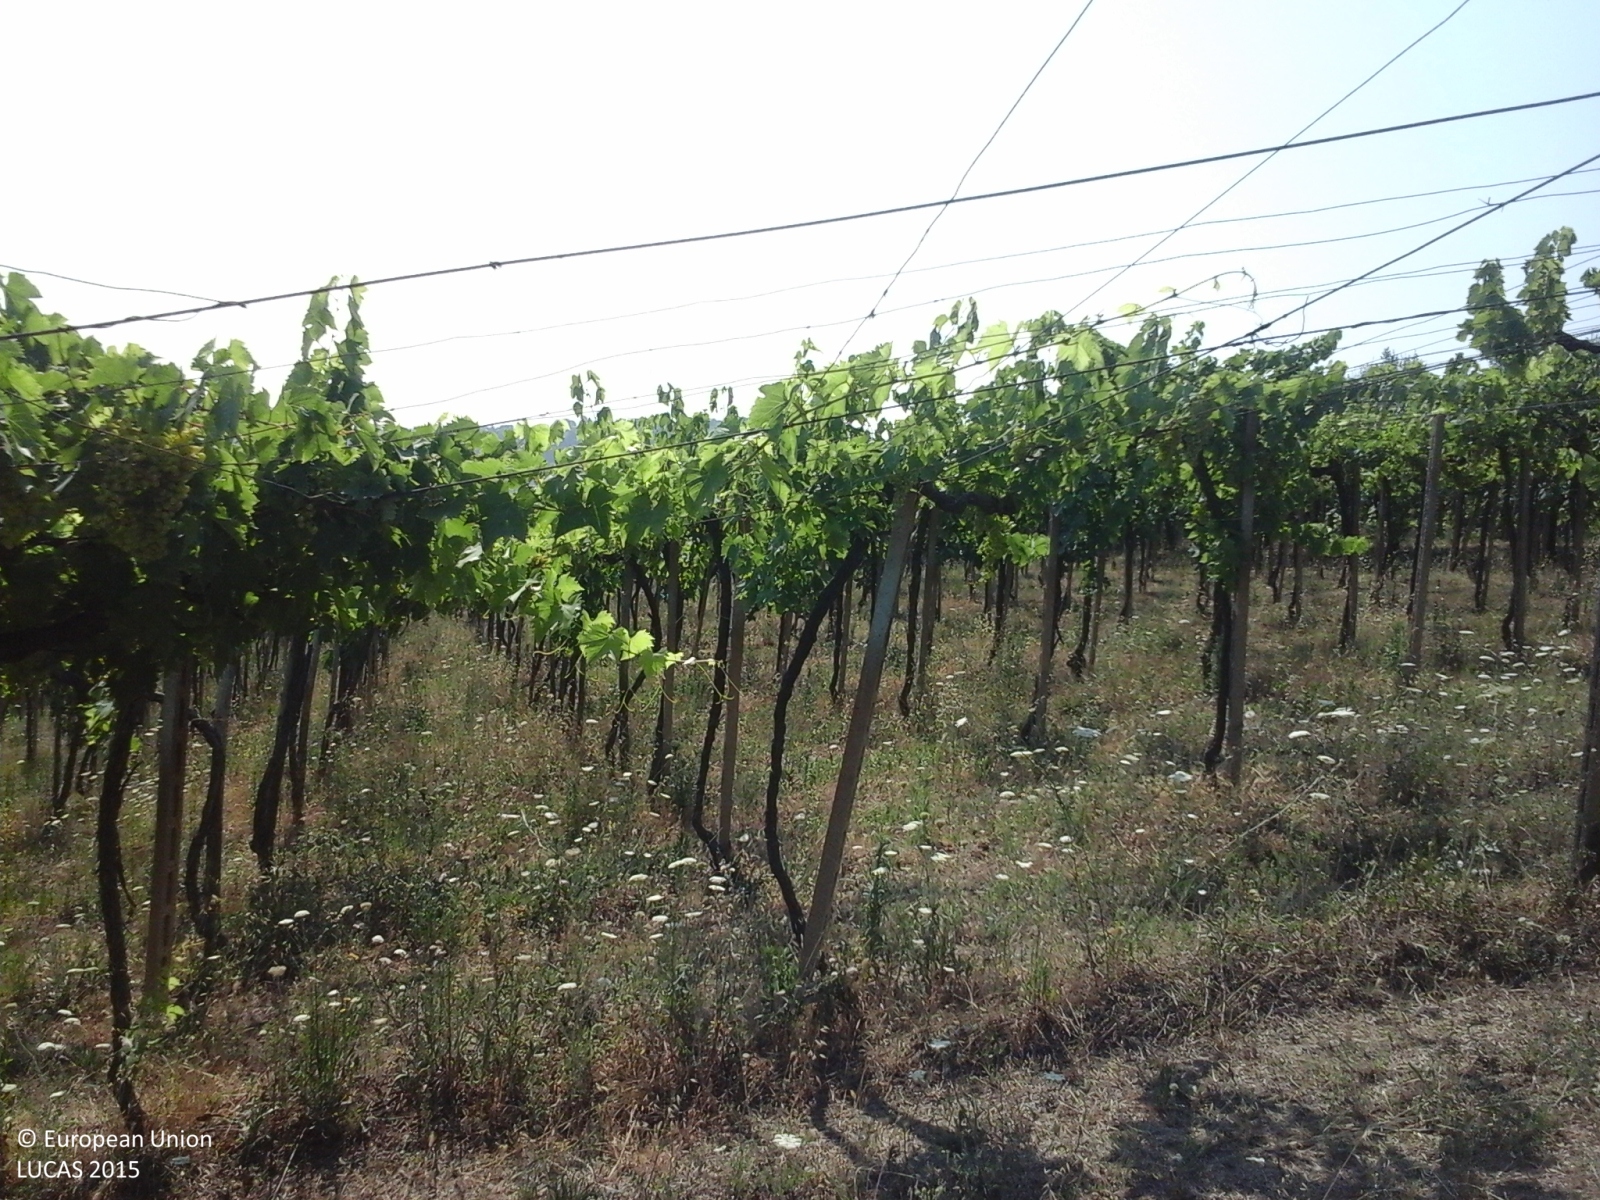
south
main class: Cropland
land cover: Vineyards
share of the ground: 50 - 75 %
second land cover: Spontaneously vegetated surfaces
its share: > 75 %
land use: Agriculture (excluding fallow land and kitchen gardens)
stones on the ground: 10 - 25 %
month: July
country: IT
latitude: 42.4200
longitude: 14.2531
